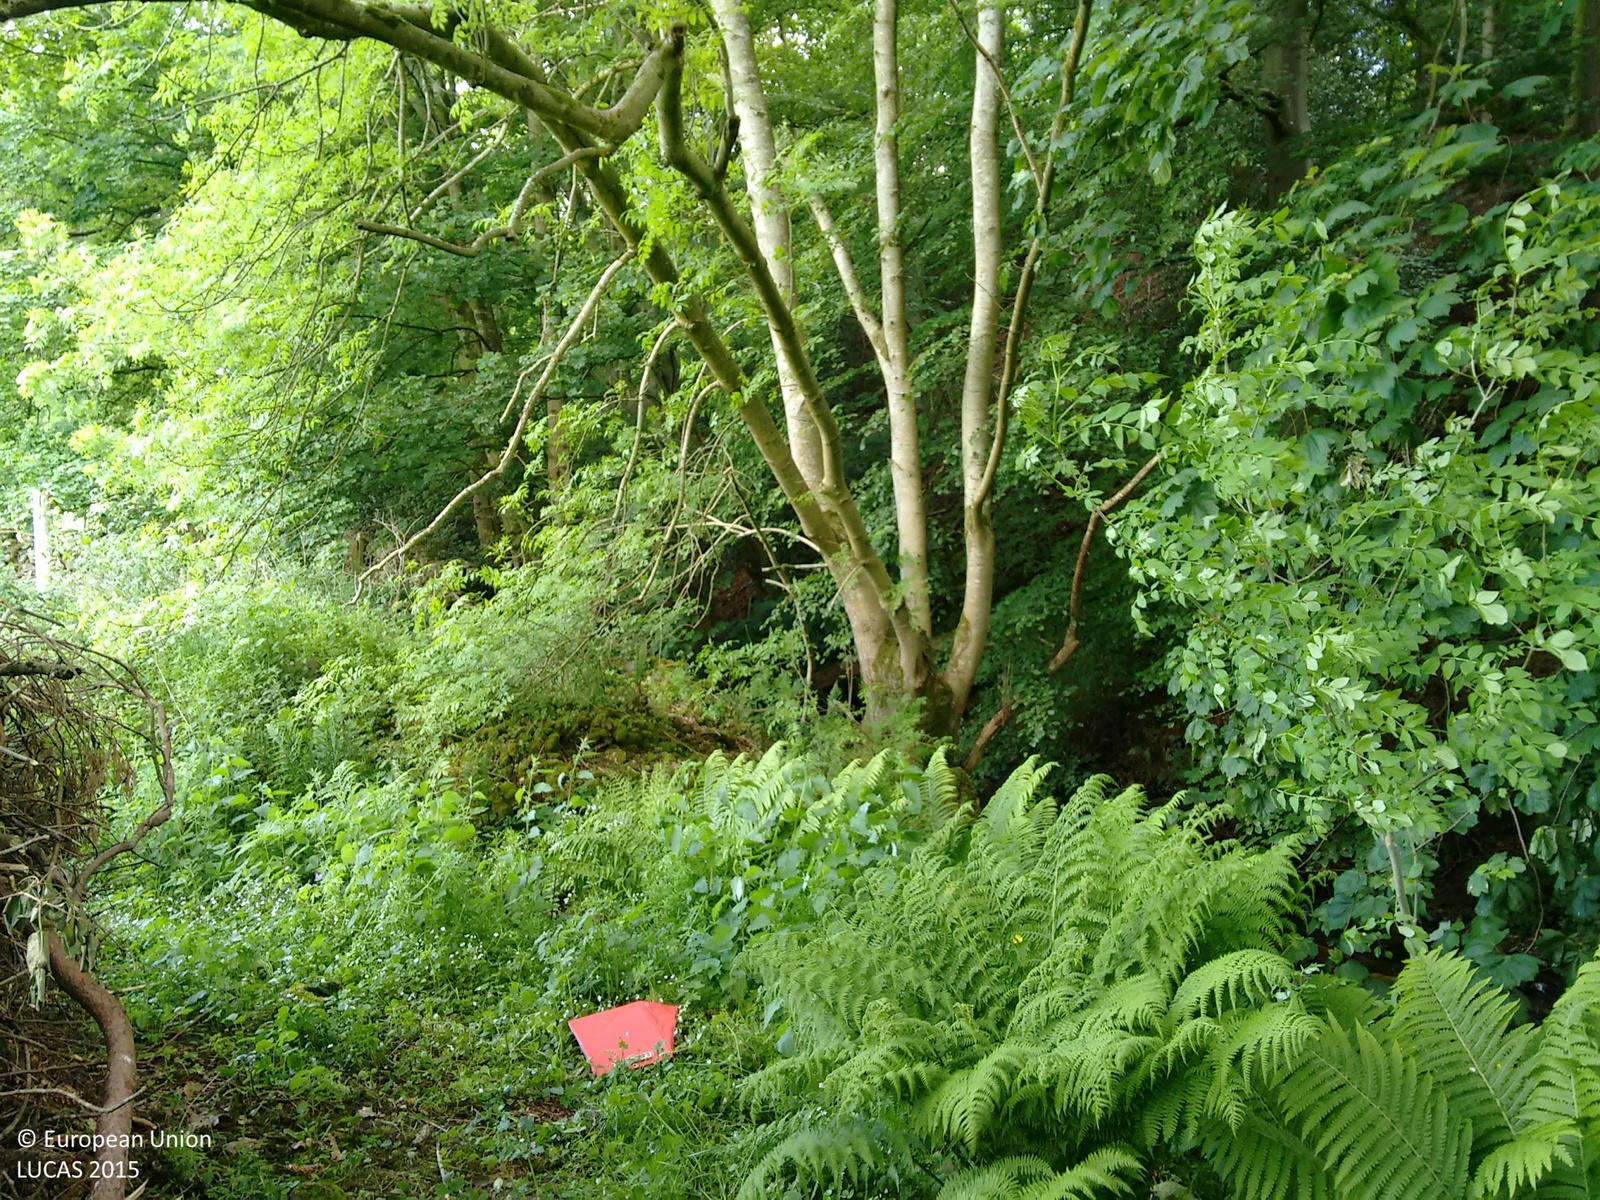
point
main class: Woodland
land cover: Broadleaved woodland
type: floodplain forest
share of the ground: > 75 %
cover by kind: broadleaved forest trees 90 %, shrubs 5 %, herbaceous plants 5 %
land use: Semi-natural and natural areas not in use
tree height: > 5 m
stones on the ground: < 10 %
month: June
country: GB
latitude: 55.3153
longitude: -3.7458
